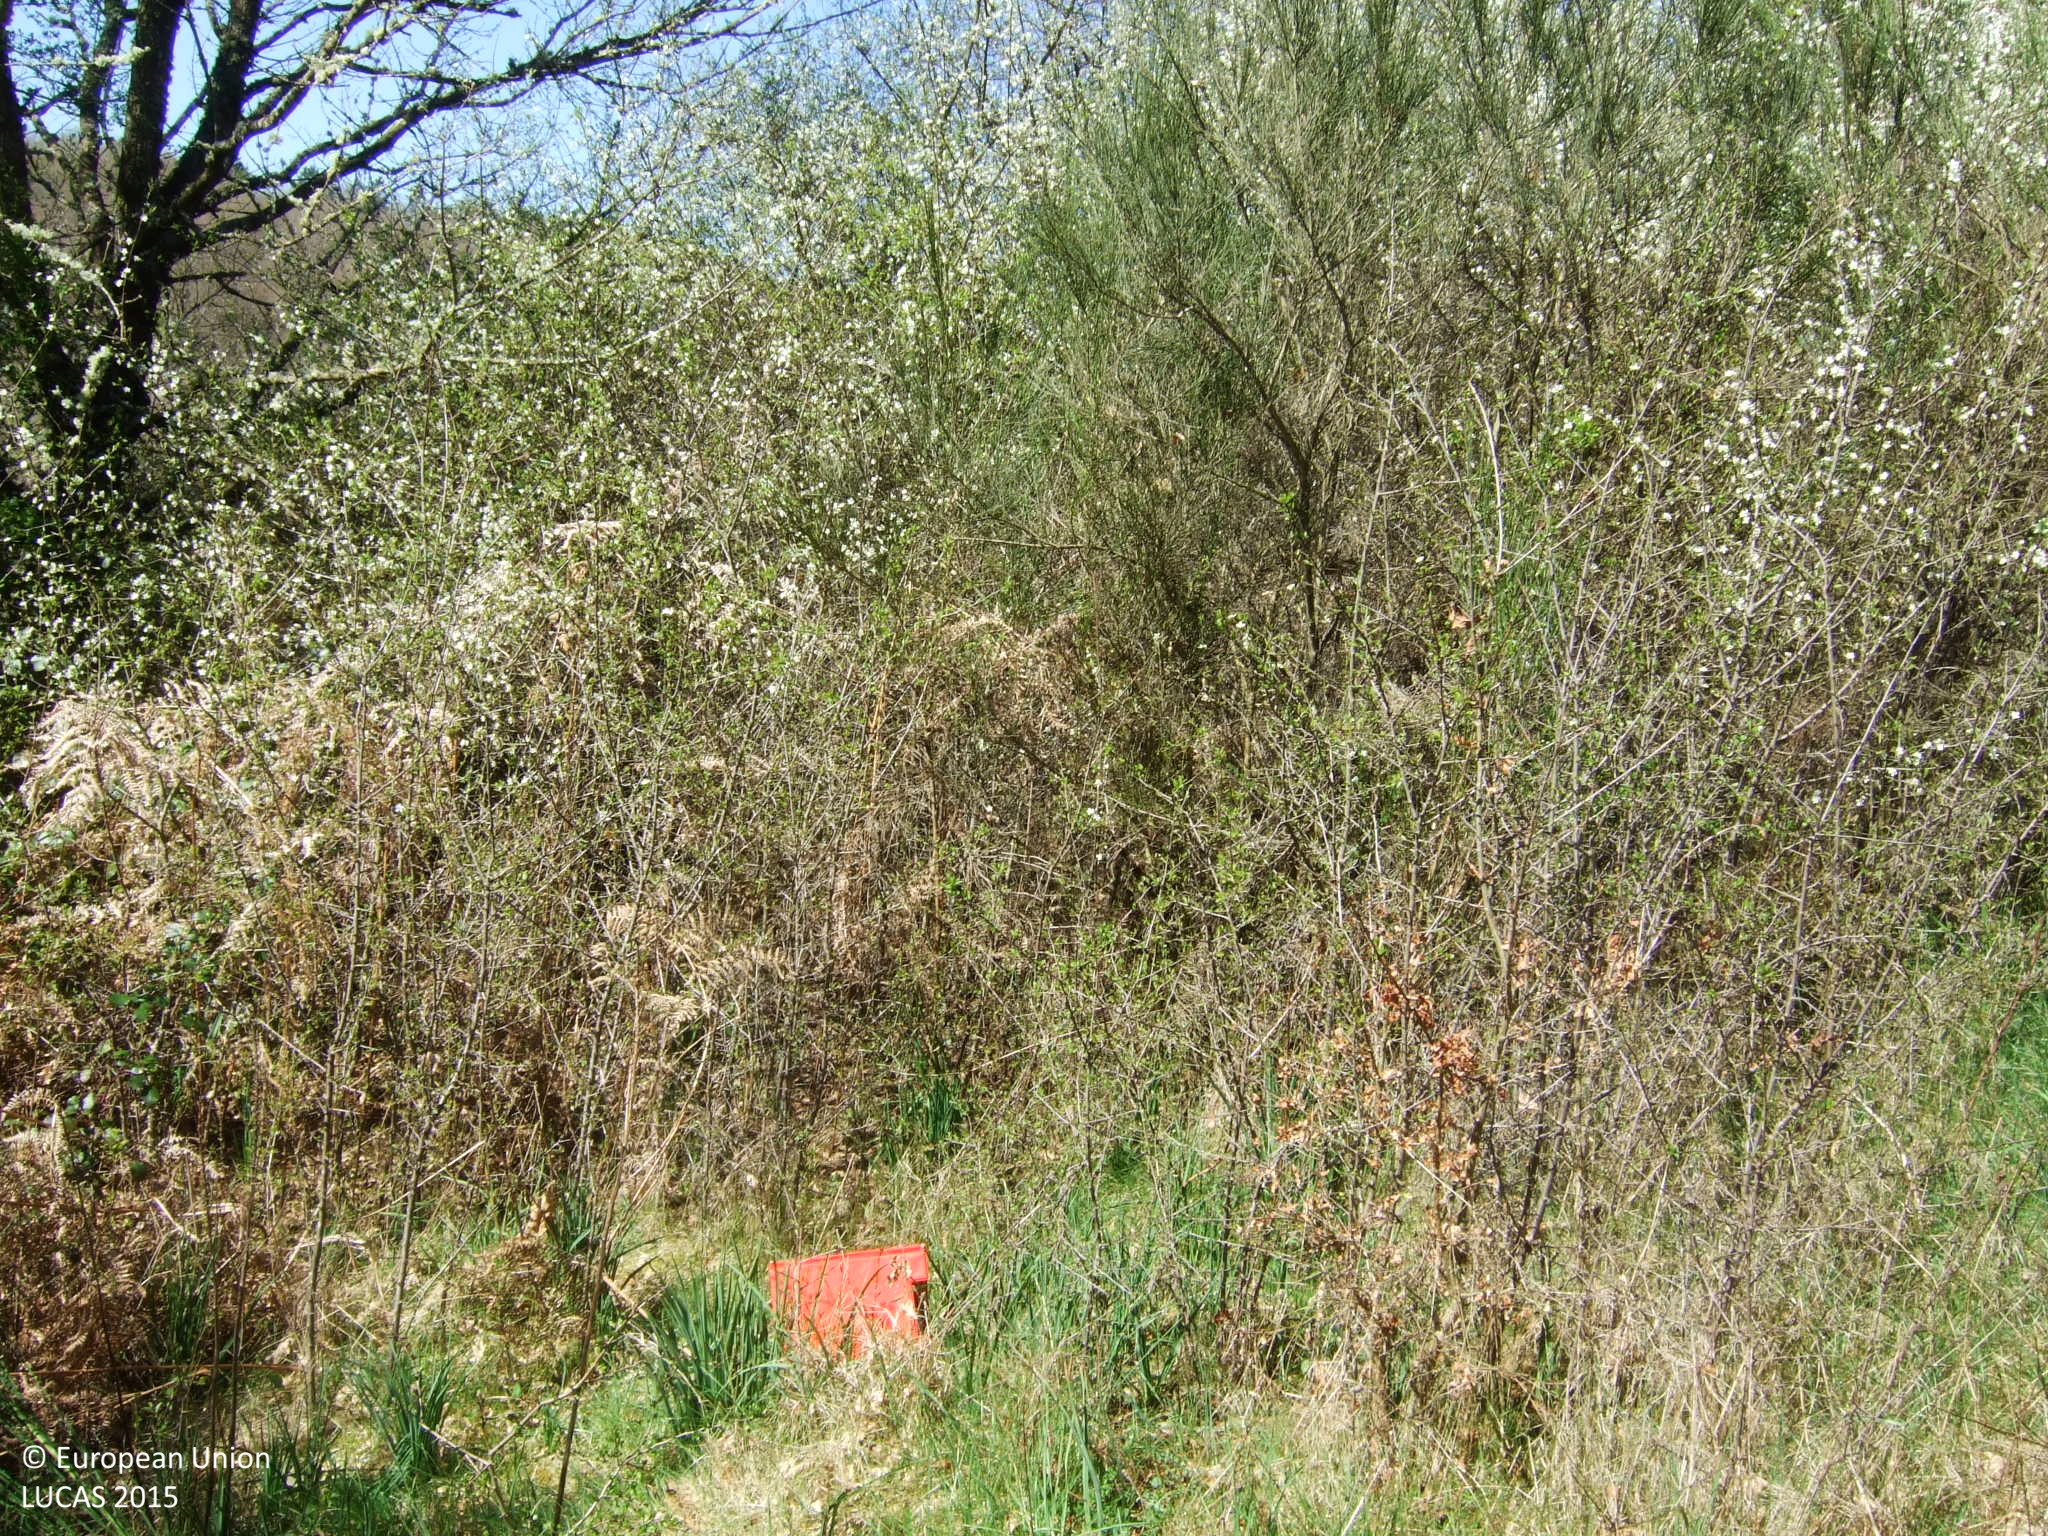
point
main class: Shrubland
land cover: Shrubland with sparse tree cover
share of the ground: > 75 %
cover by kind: shrubs 75 %, herbaceous plants 20 %, broadleaved forest trees 5 %
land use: Semi-natural and natural areas not in use
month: April
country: ES
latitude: 42.7050
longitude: -7.7946
